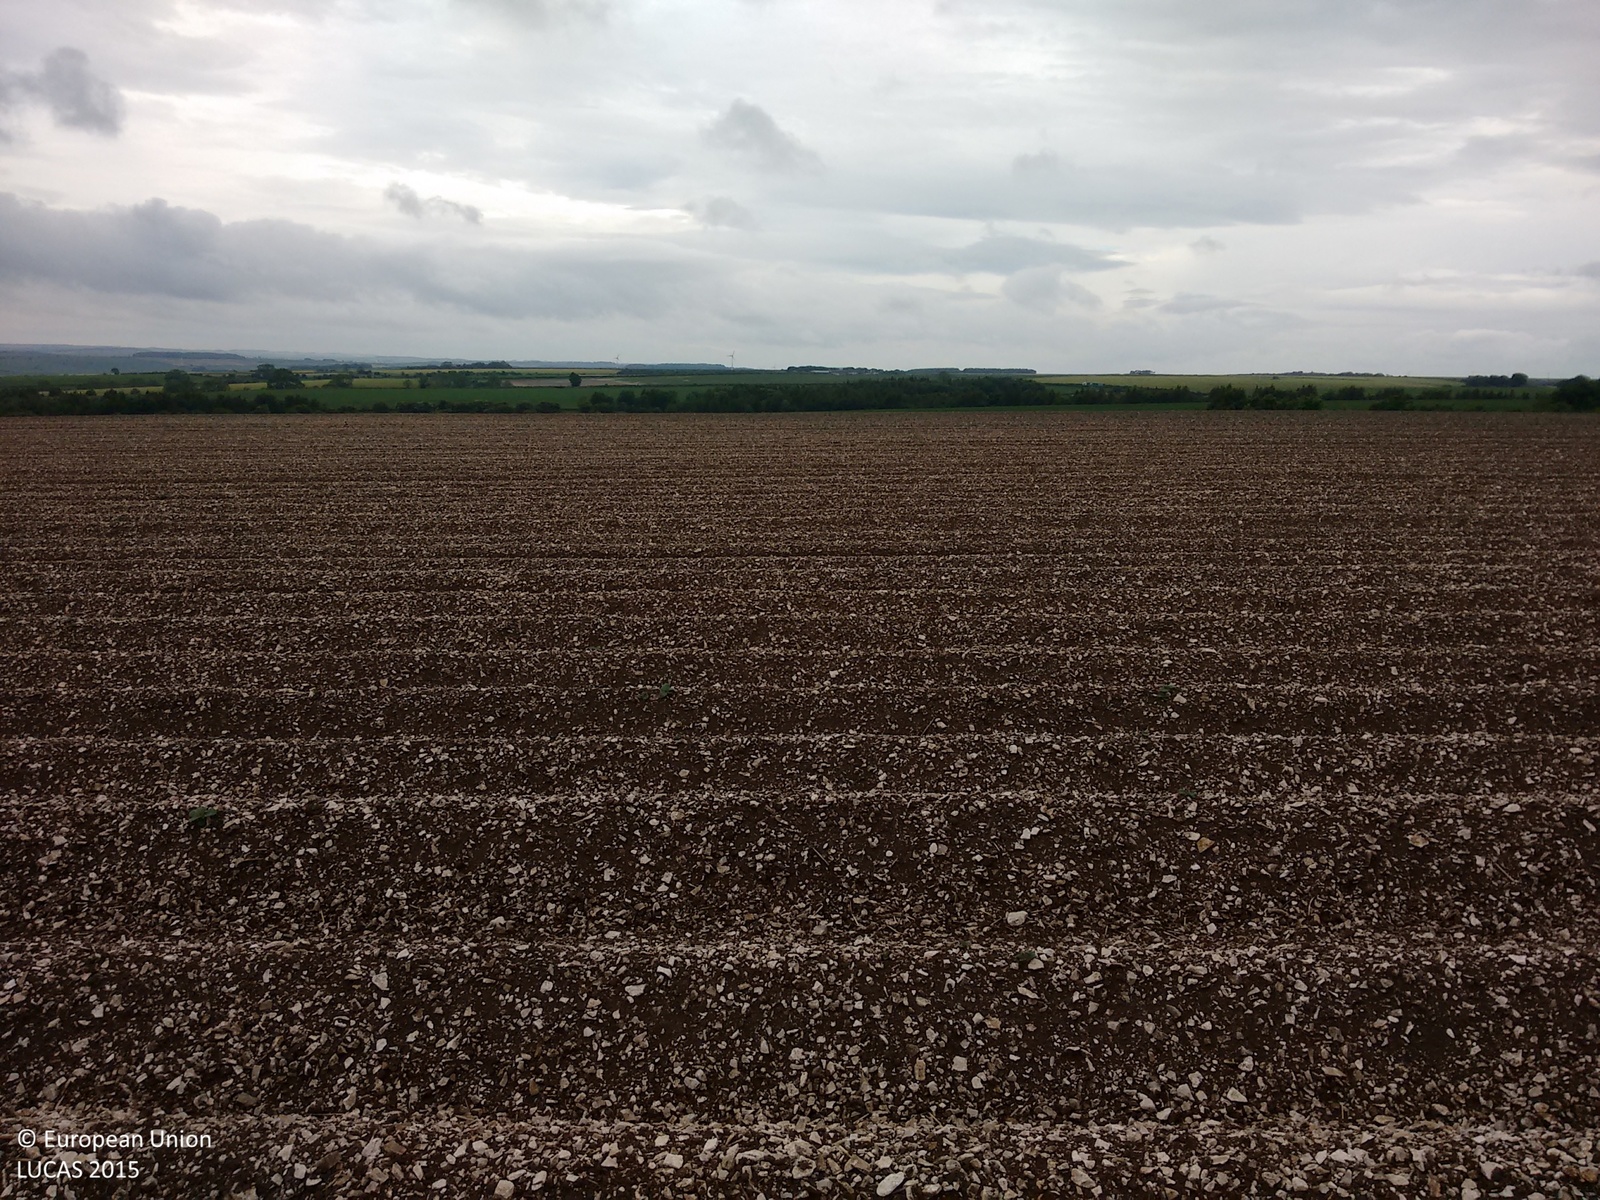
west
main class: Cropland
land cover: Potatoes
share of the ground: < 10 %
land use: Agriculture (excluding fallow land and kitchen gardens)
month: June
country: GB
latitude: 54.1649
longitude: -0.4353
